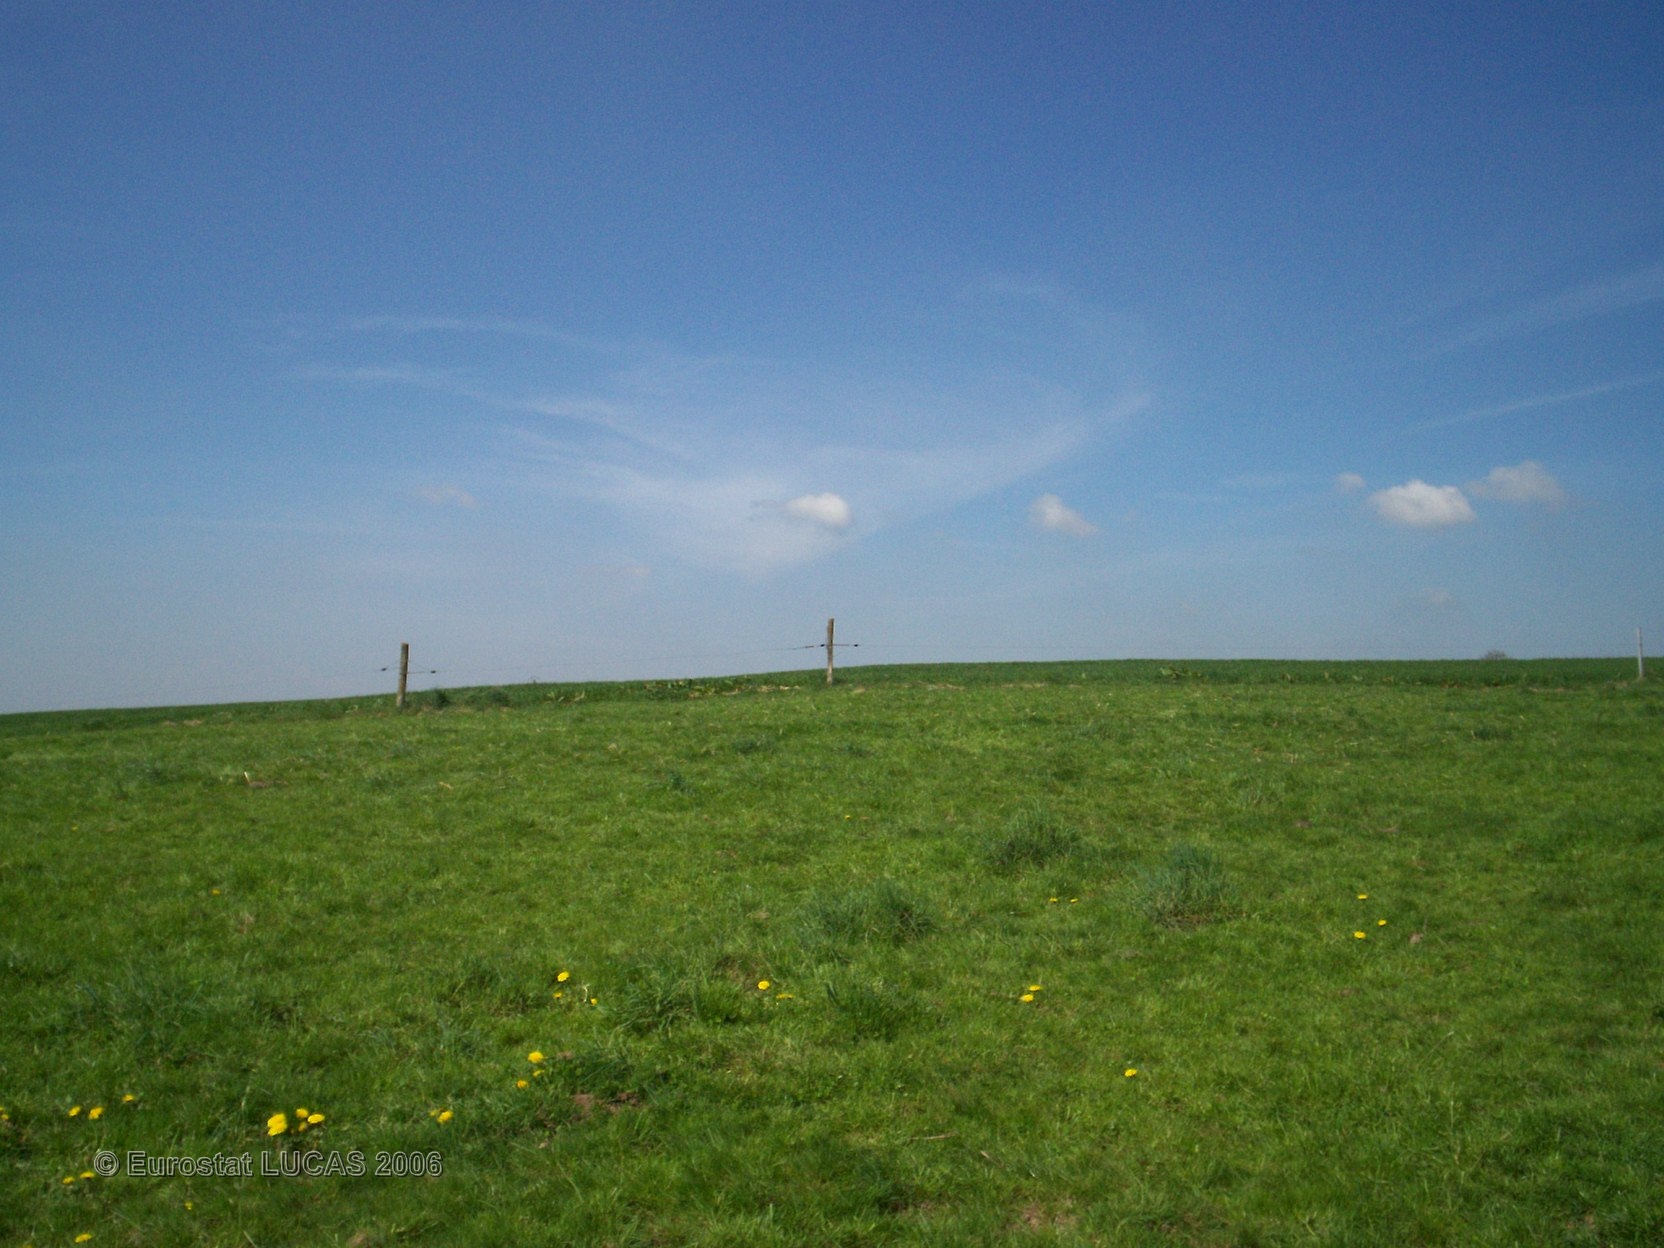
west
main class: Grassland
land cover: Grassland without tree/shrub cover
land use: Agriculture (excluding fallow land and kitchen gardens)
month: April
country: FR
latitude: 49.6508
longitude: 4.4141
